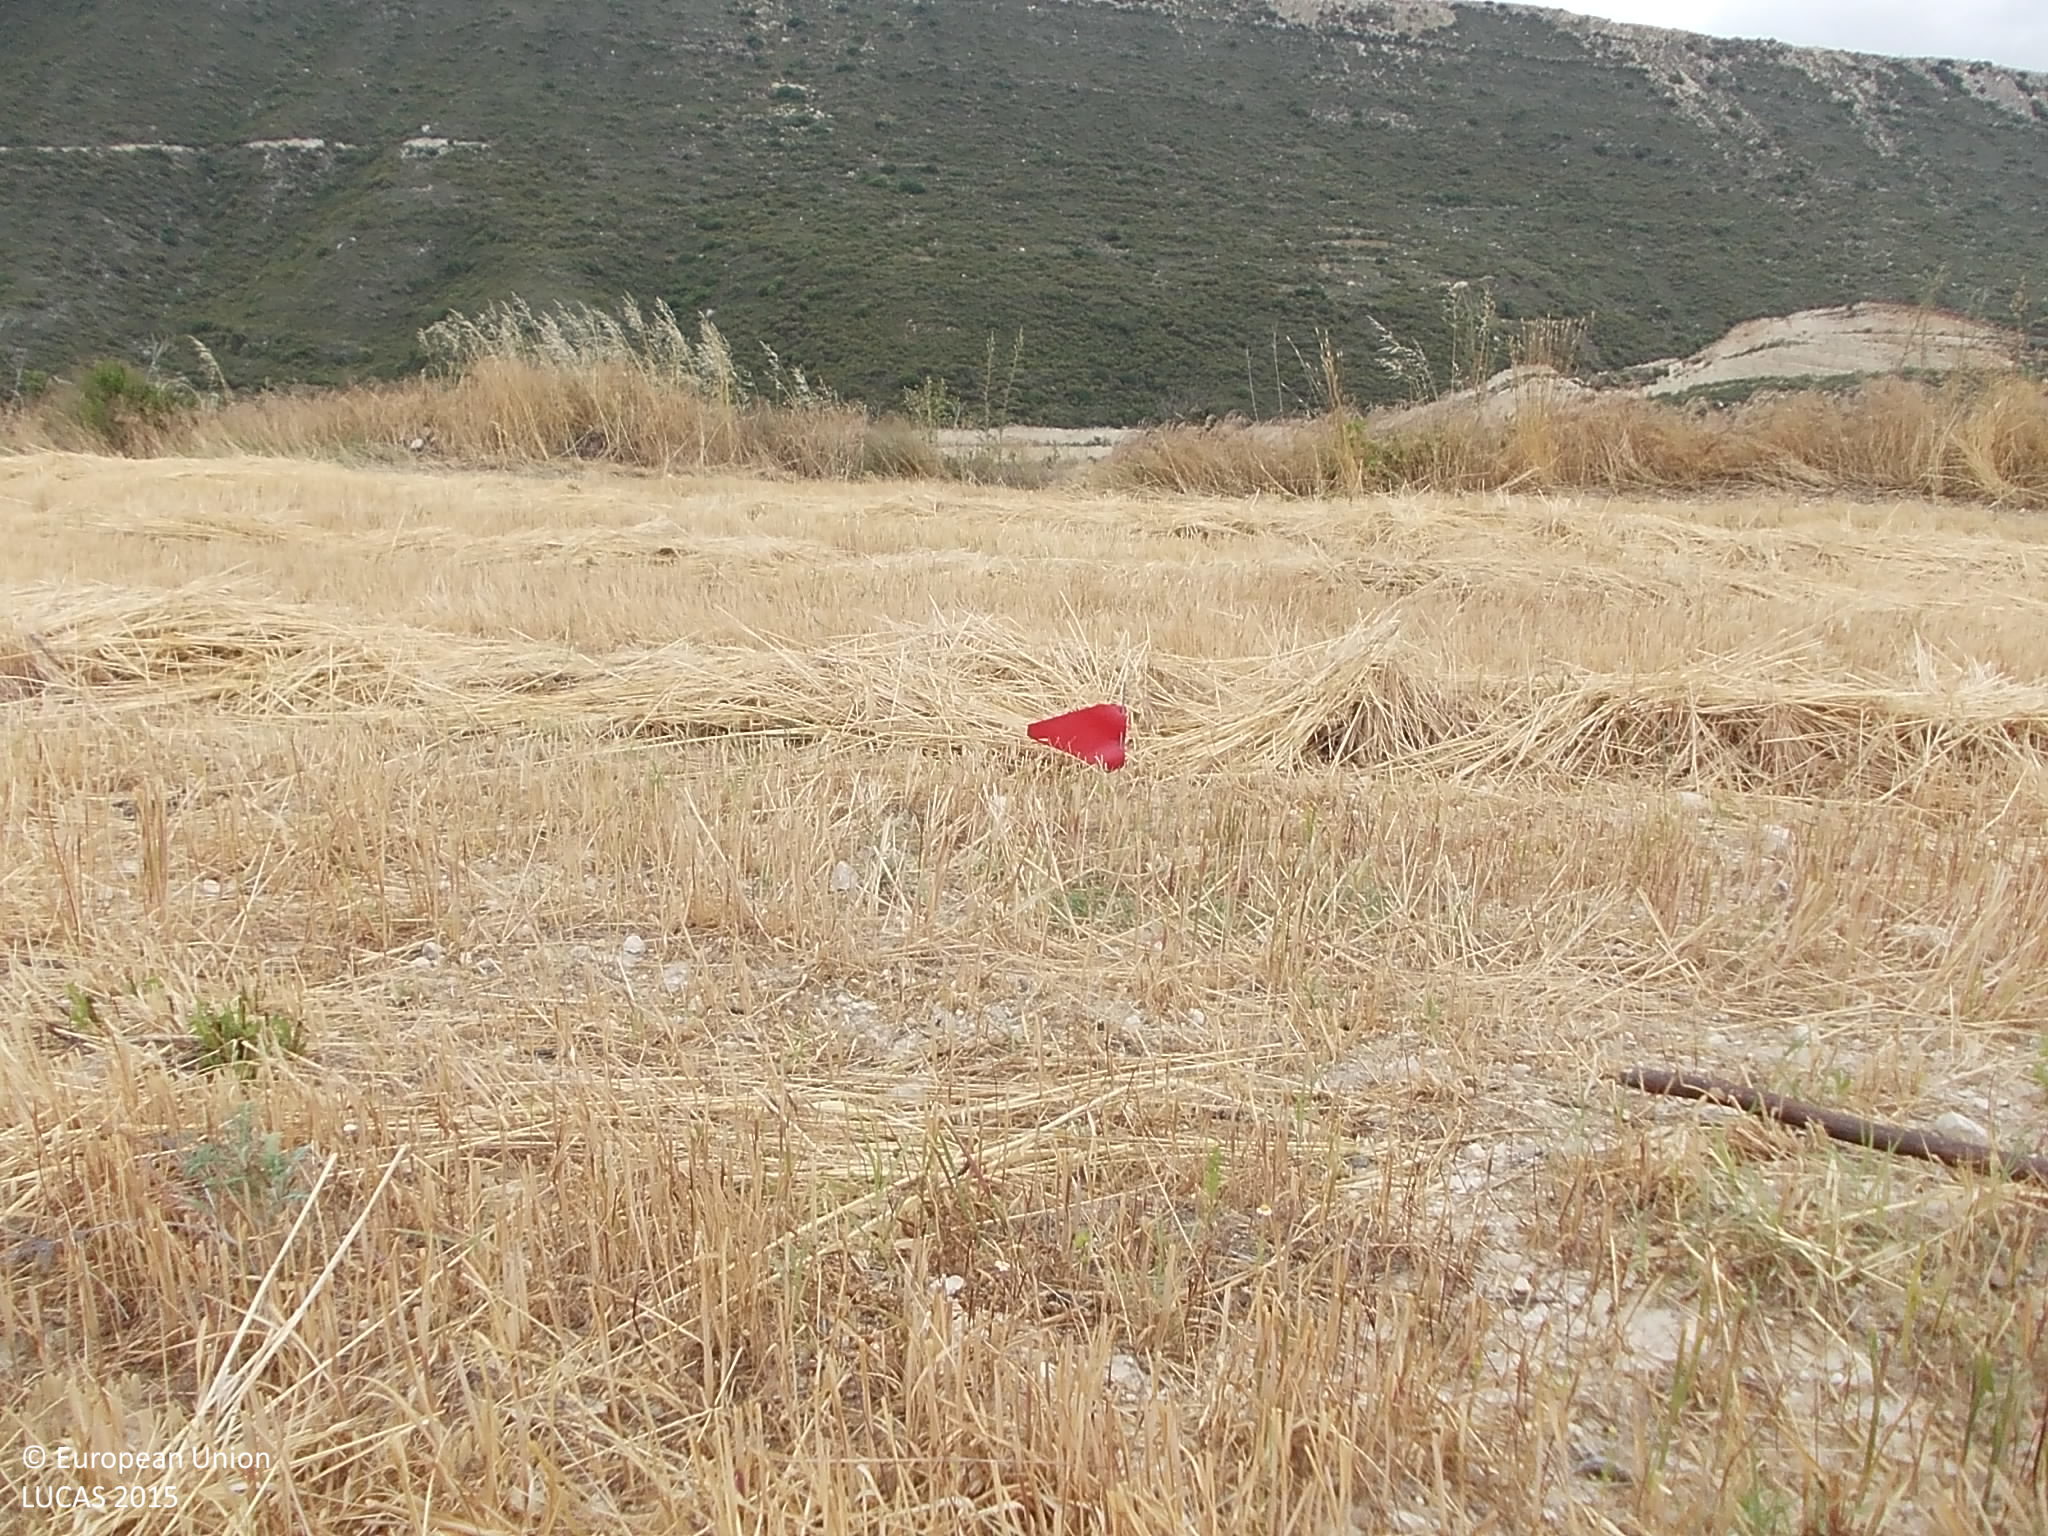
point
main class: Cropland
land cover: Oats
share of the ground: > 75 %
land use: Agriculture (excluding fallow land and kitchen gardens)
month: May
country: CY
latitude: 34.7678
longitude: 32.8083
